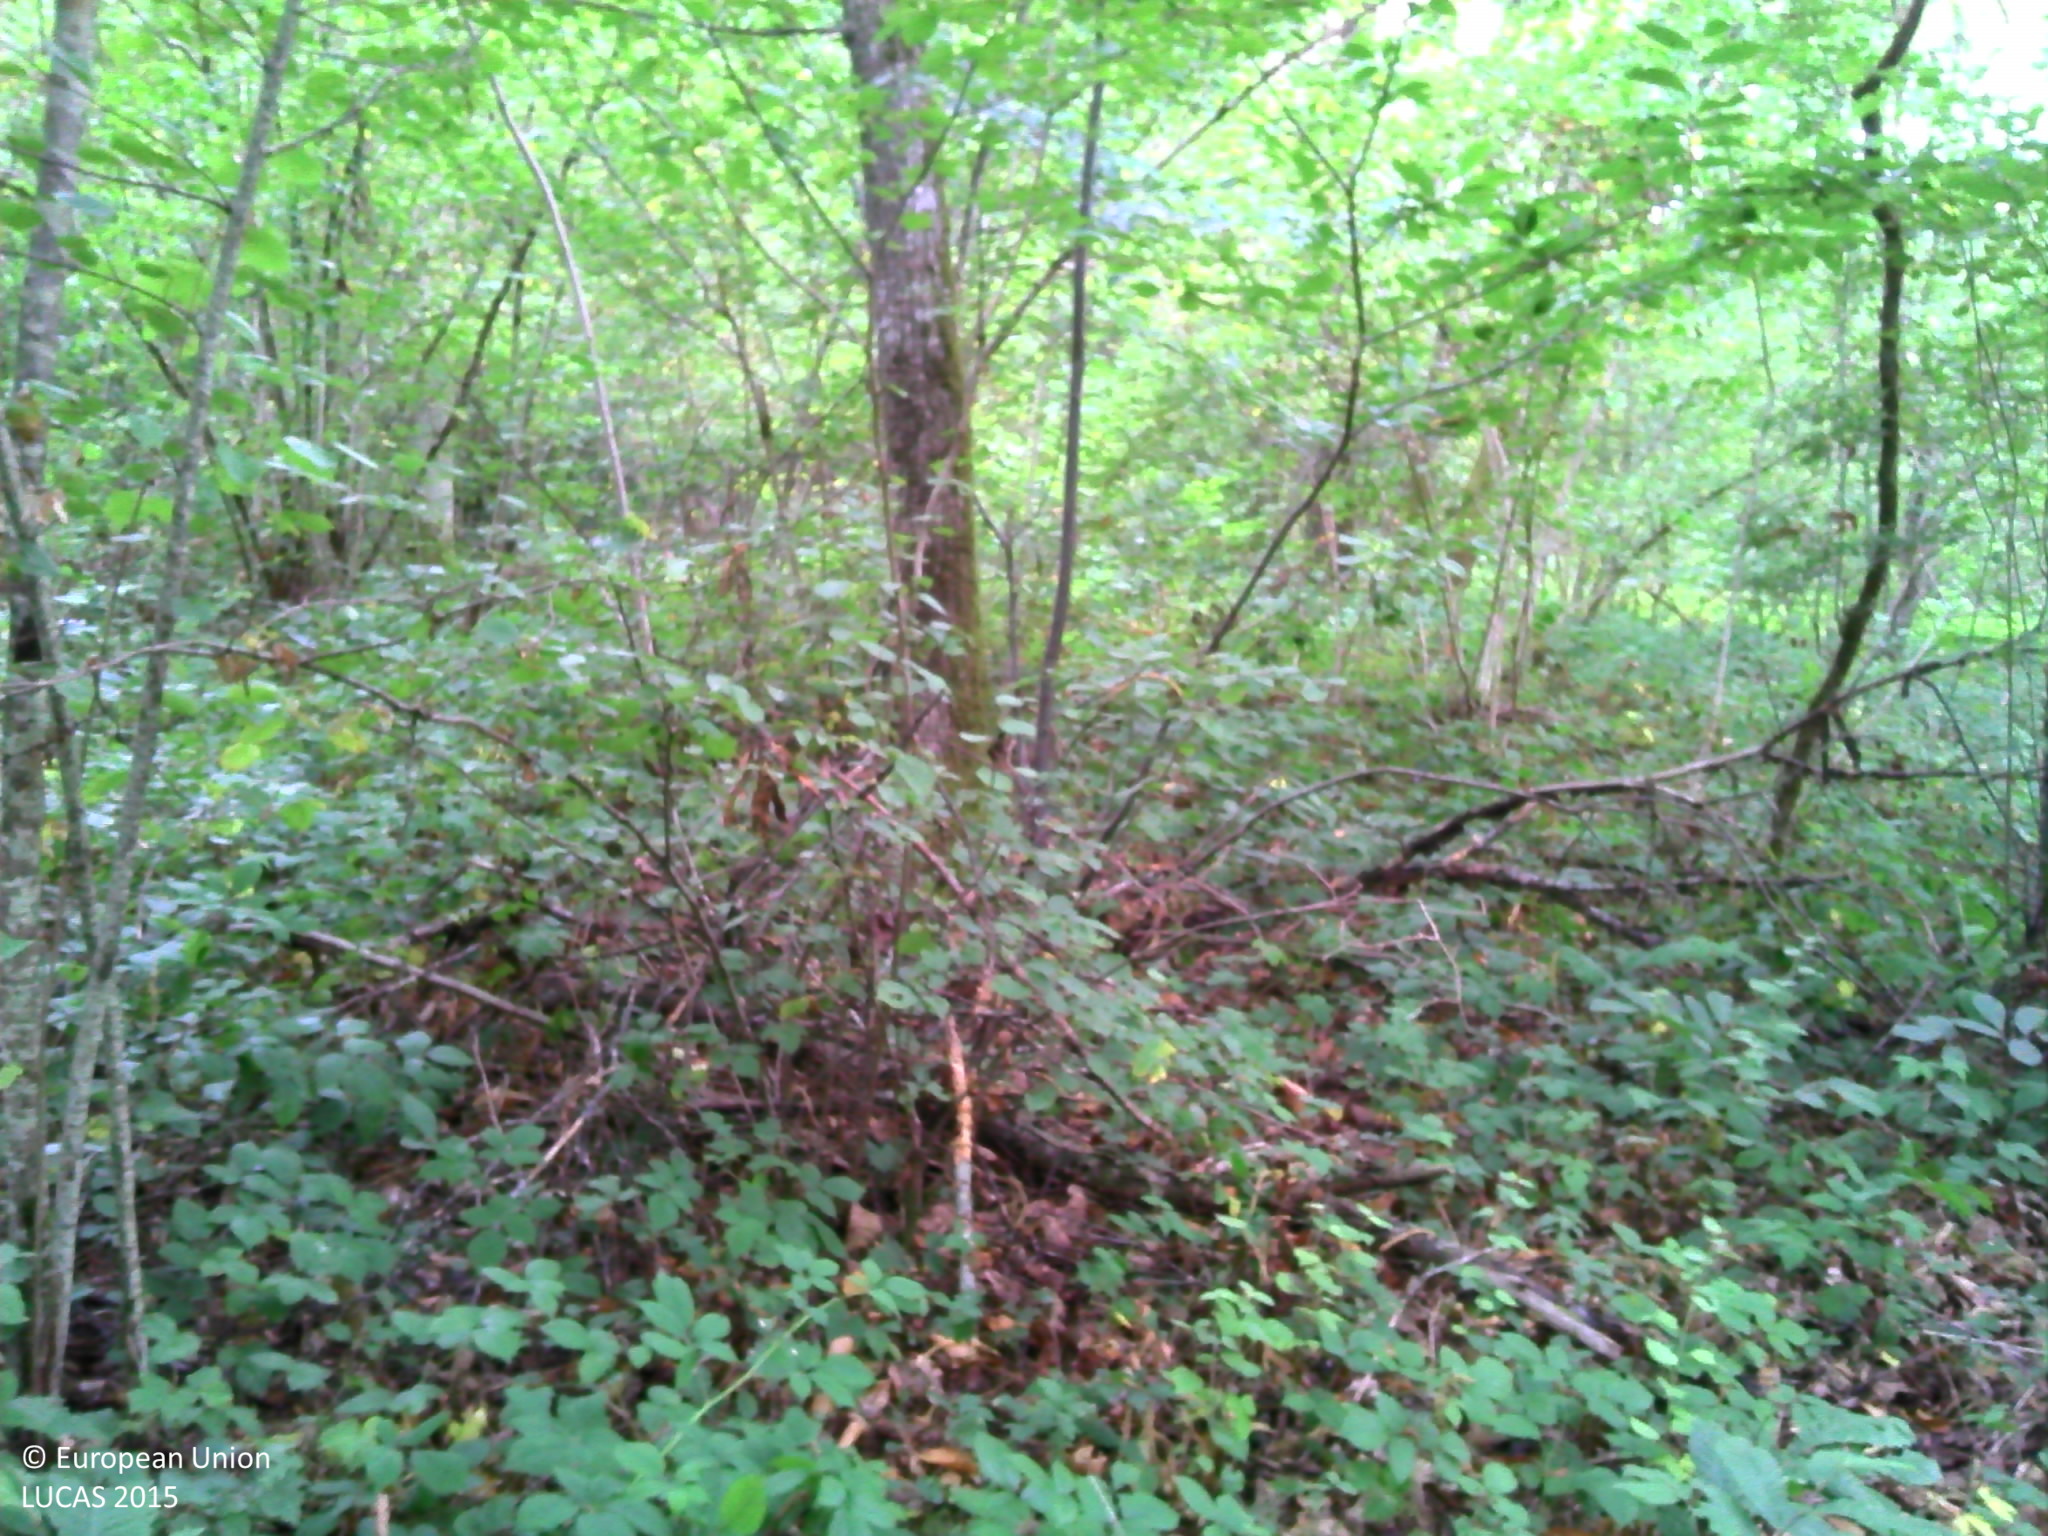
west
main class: Woodland
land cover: Broadleaved woodland
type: mesophytic deciduous forest
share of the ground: > 75 %
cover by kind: broadleaved forest trees 90 %, herbaceous plants 5 %, lichens and mosses 5 %
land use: Forestry
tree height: > 5 m
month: July
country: FR
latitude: 48.1354
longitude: 3.4233
